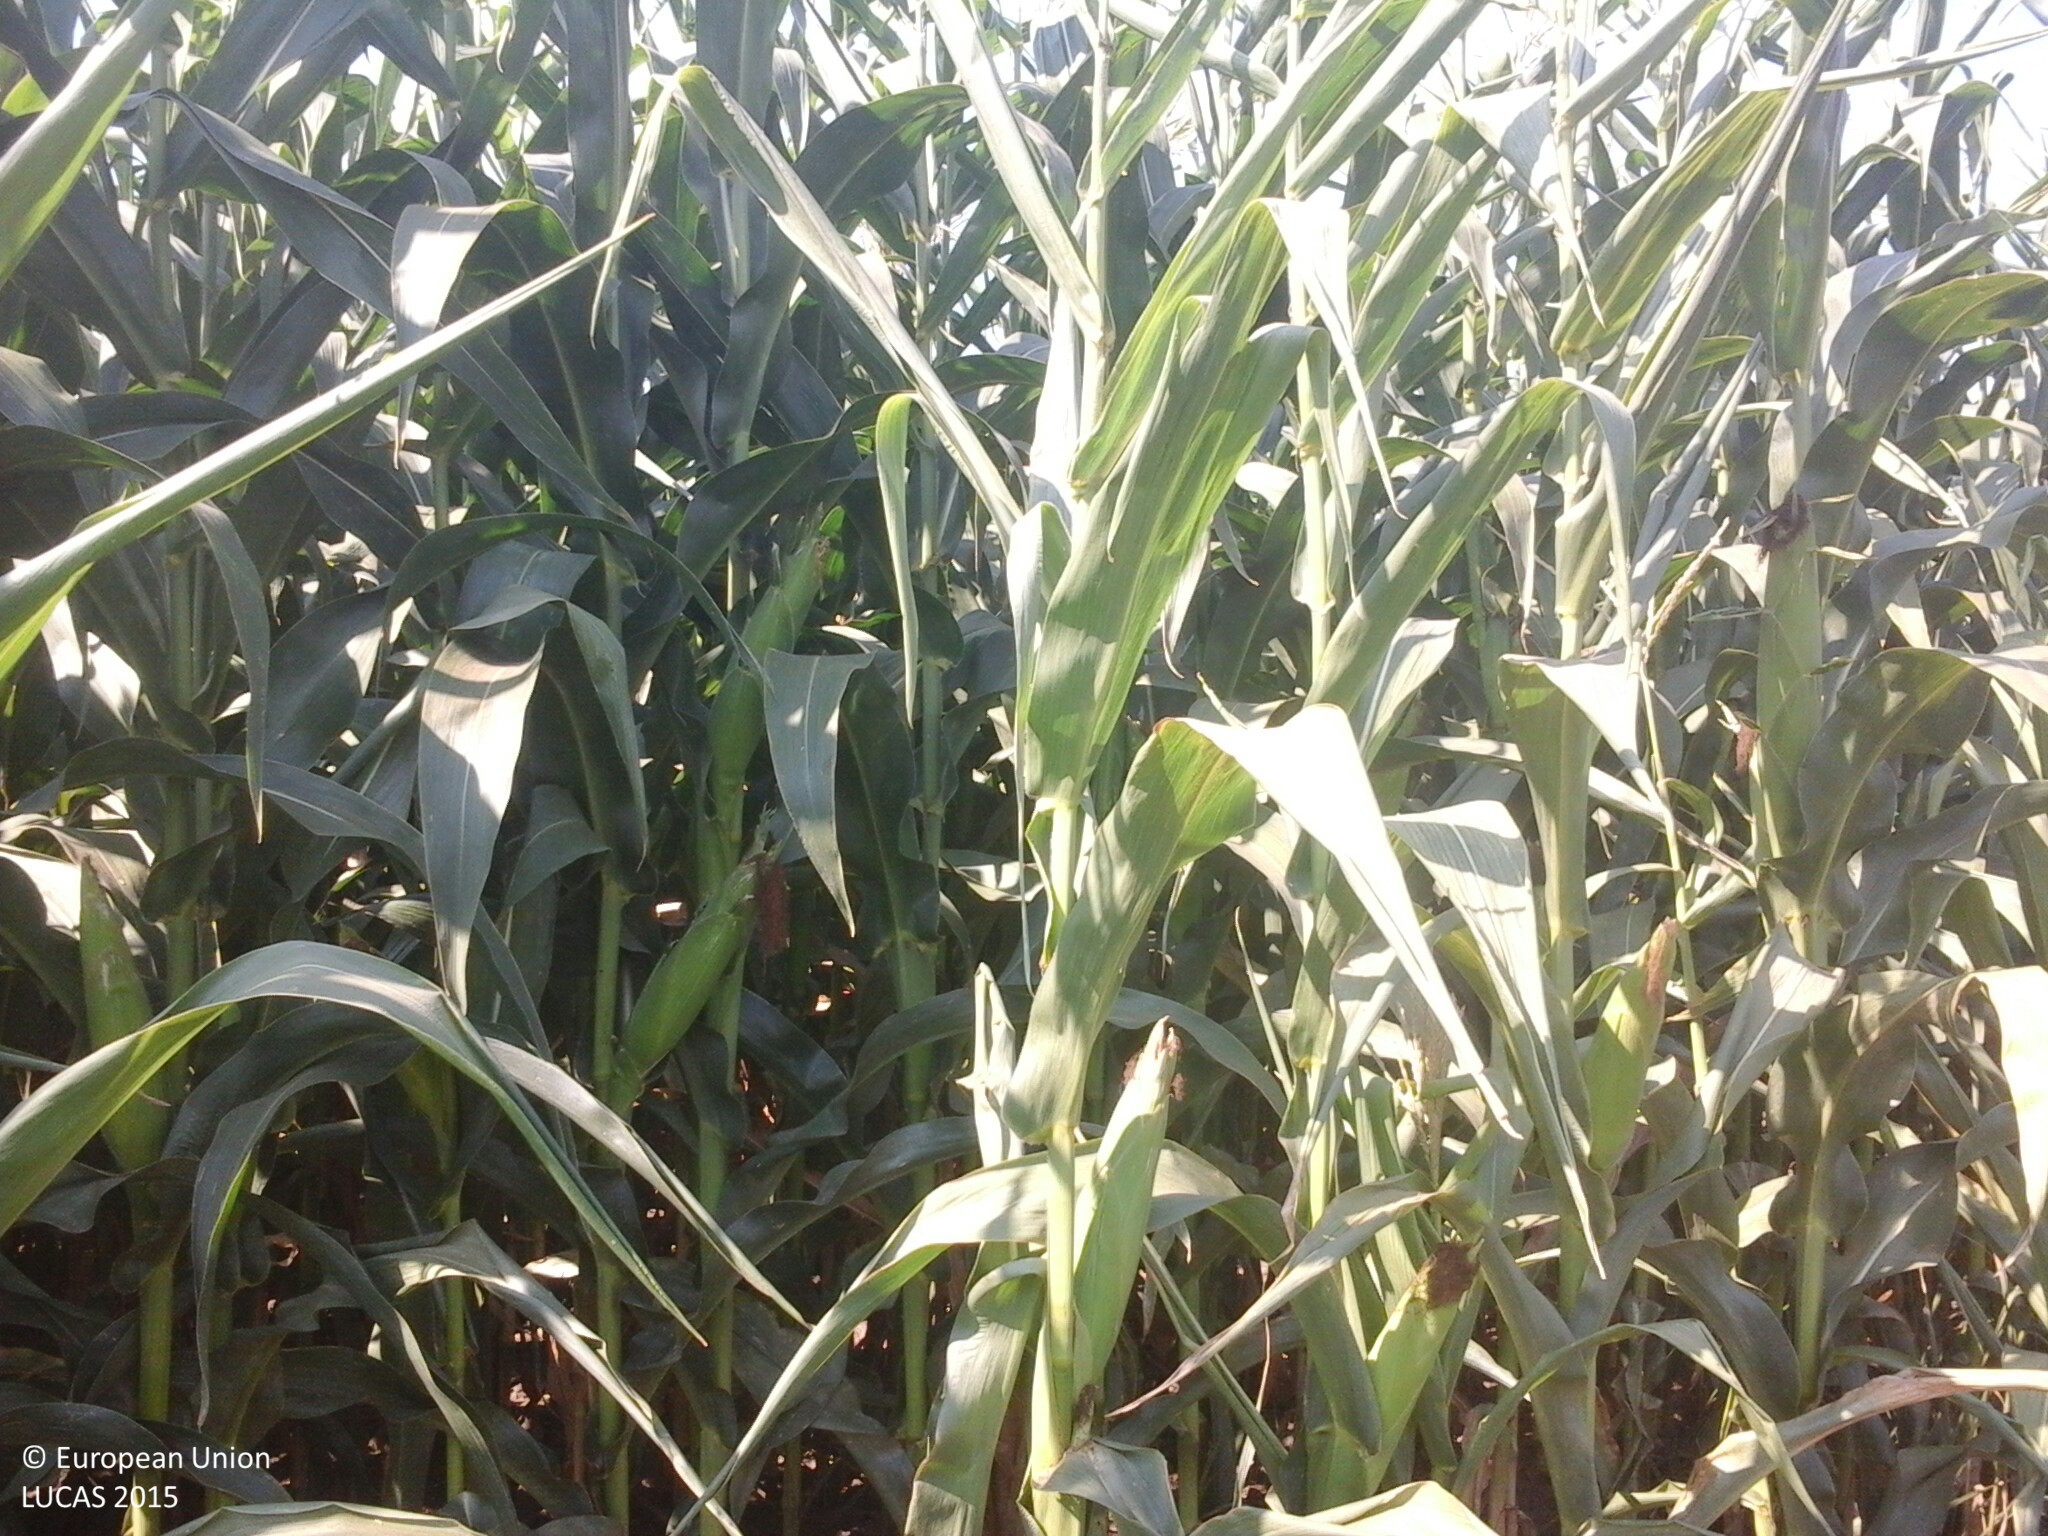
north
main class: Cropland
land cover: Maize
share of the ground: > 75 %
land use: Agriculture (excluding fallow land and kitchen gardens)
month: August
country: HU
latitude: 46.7919
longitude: 18.4873
